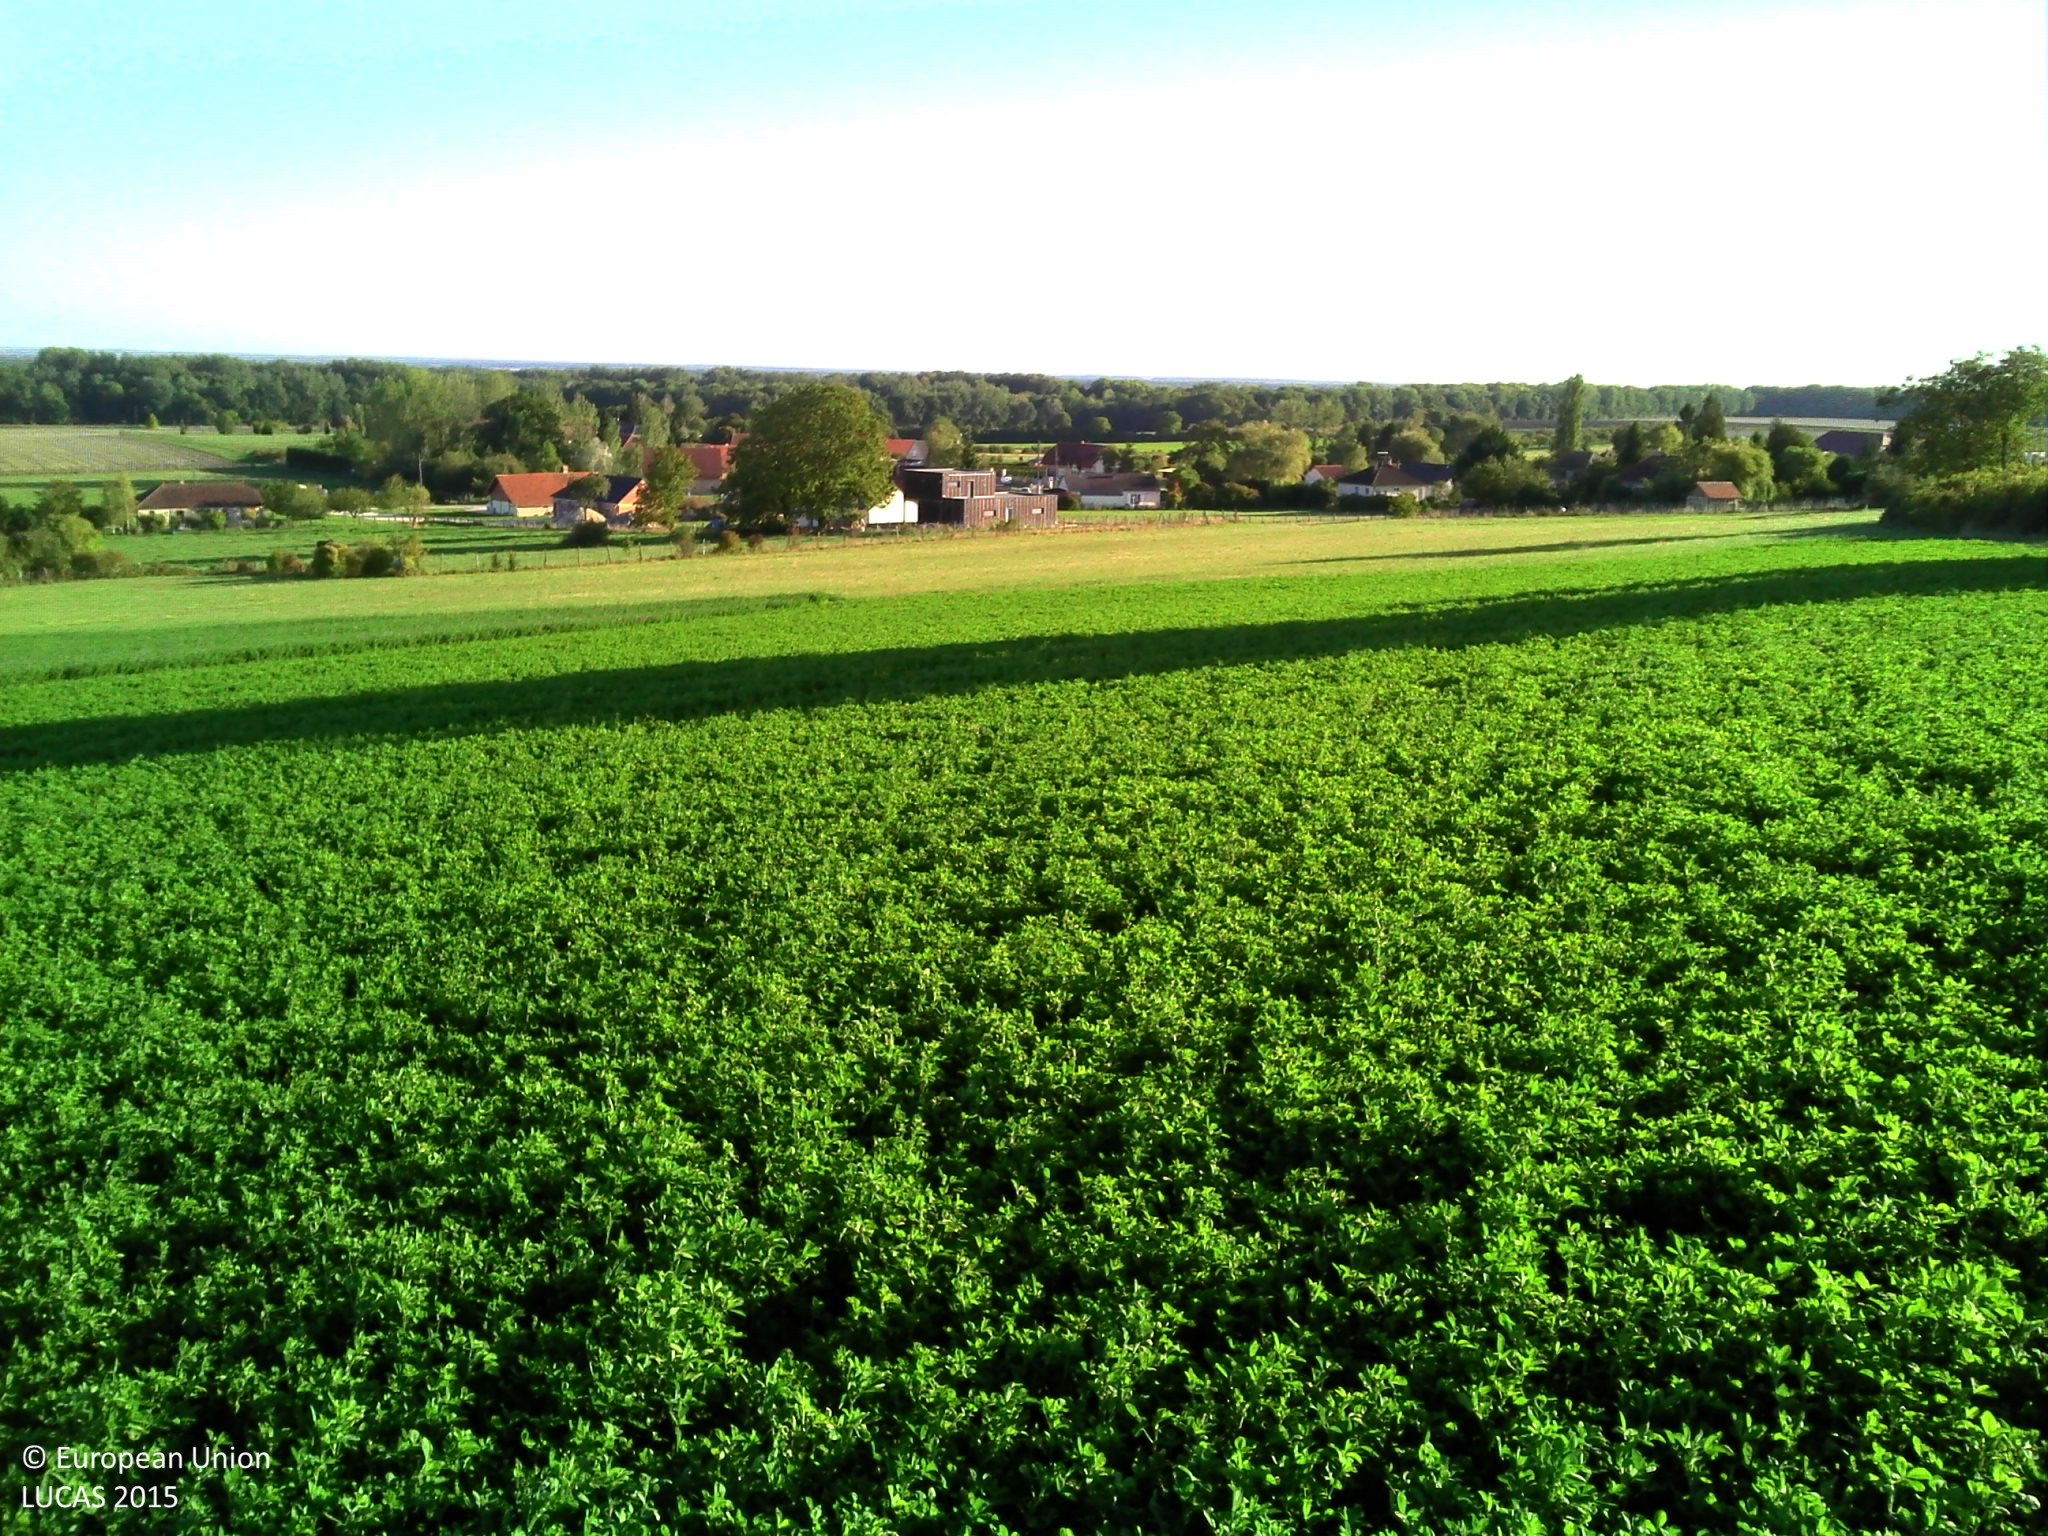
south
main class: Cropland
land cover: Lucerne
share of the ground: > 75 %
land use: Agriculture (excluding fallow land and kitchen gardens)
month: September
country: FR
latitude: 48.3075
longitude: 4.2397
